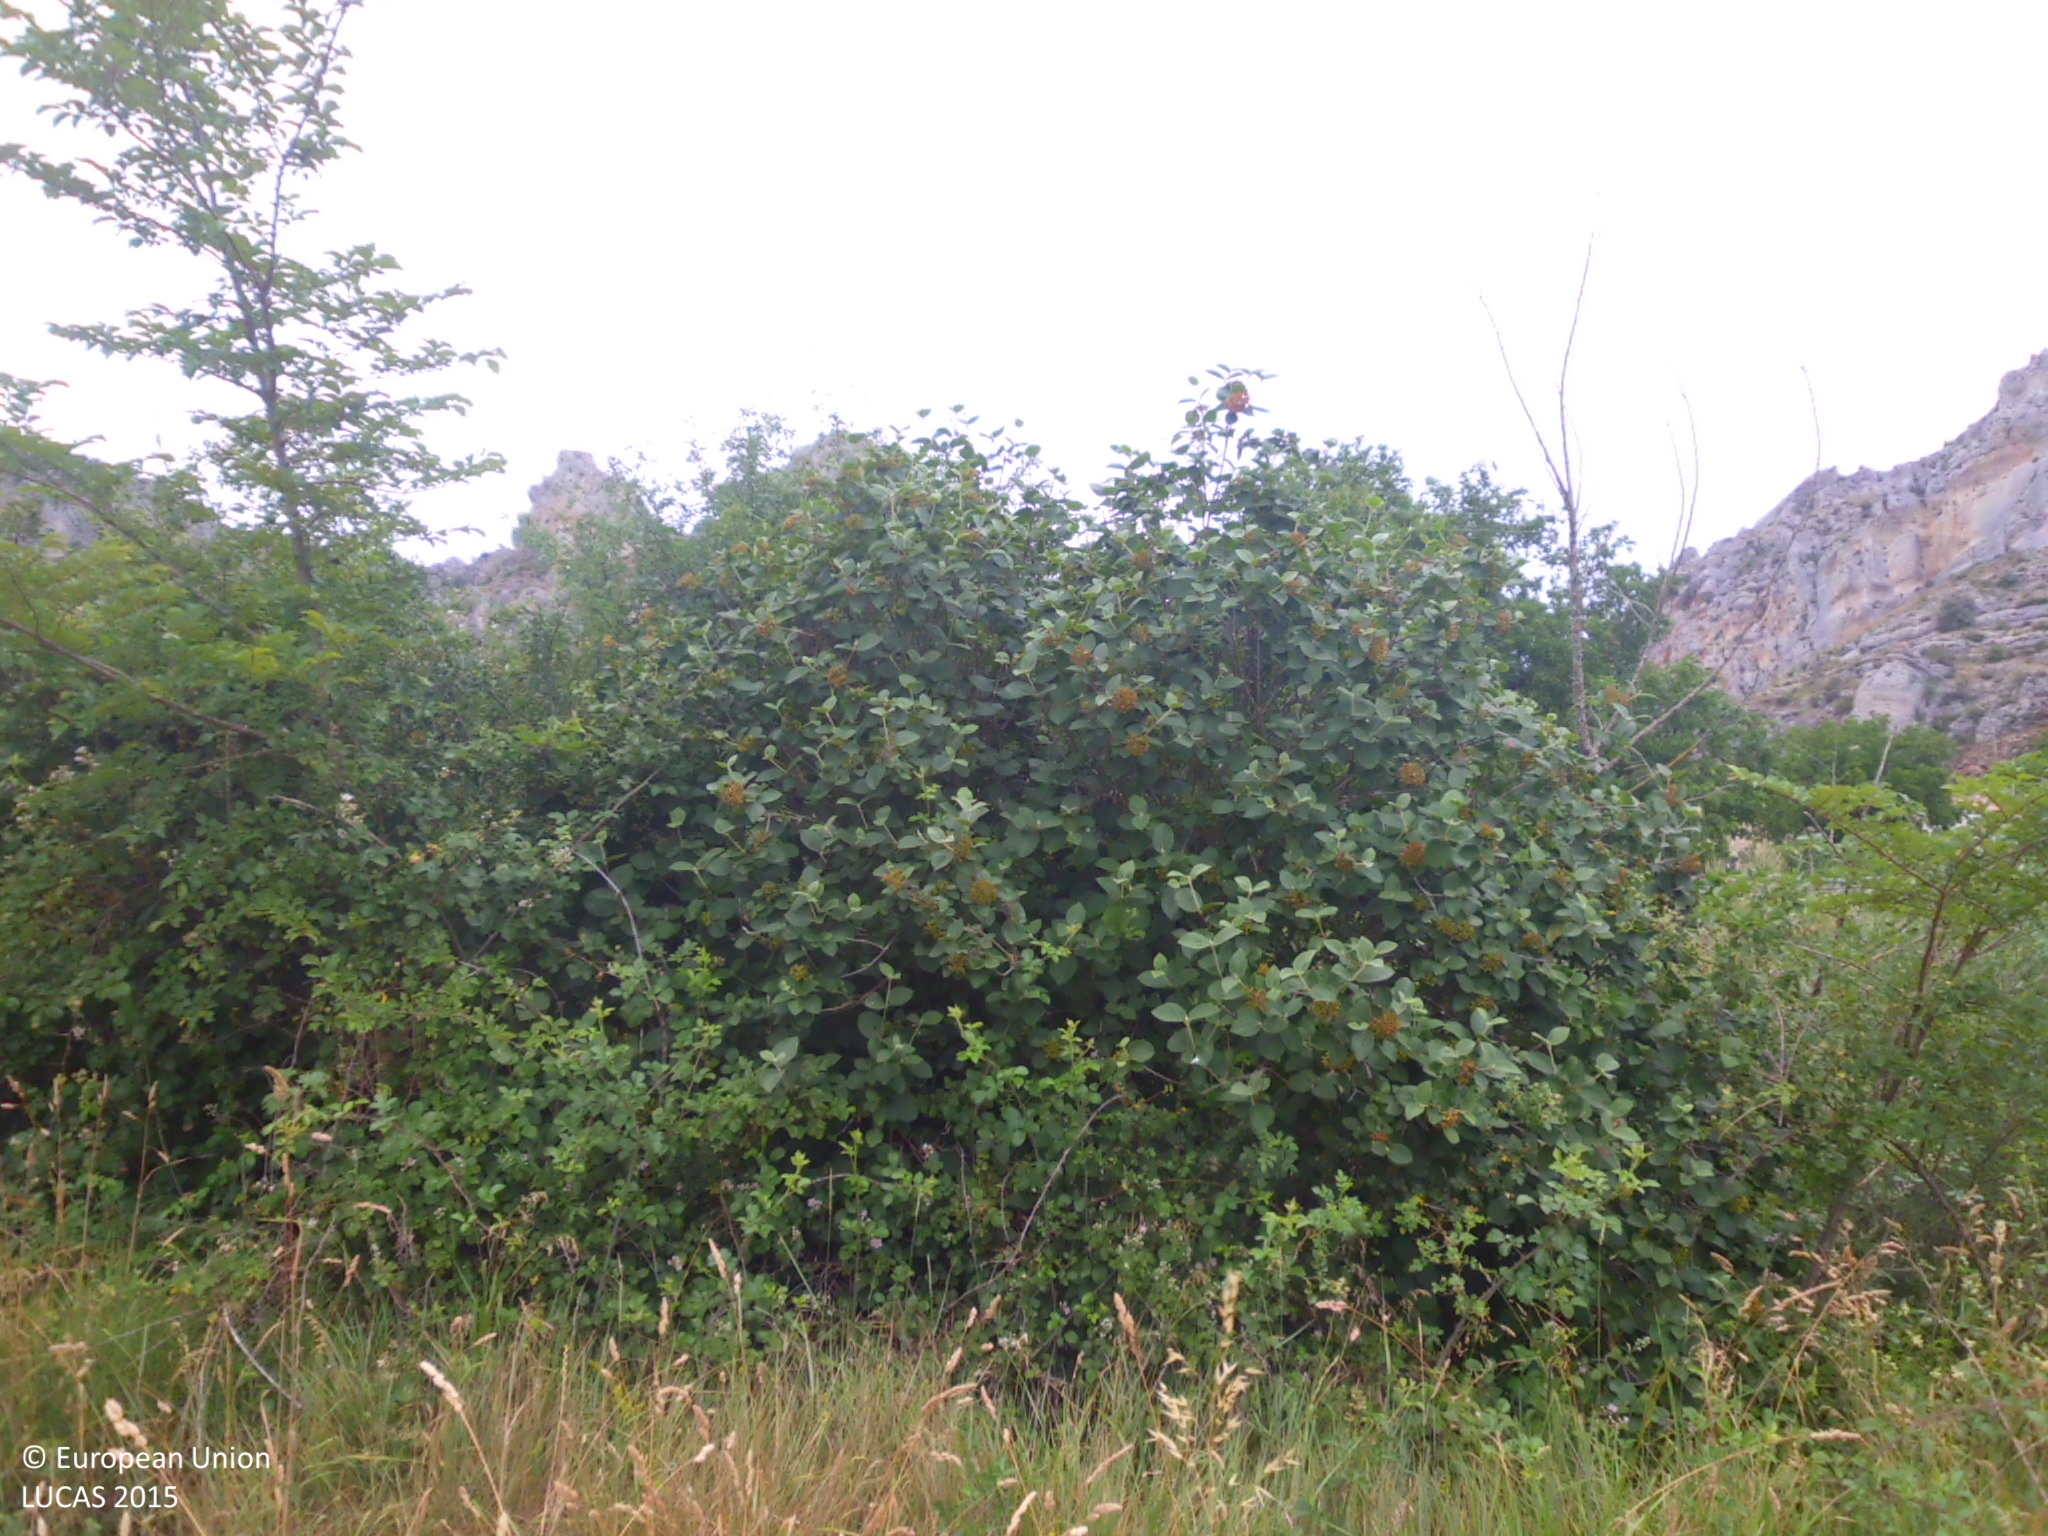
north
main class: Cropland
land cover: Common wheat
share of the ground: > 75 %
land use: Agriculture (excluding fallow land and kitchen gardens)
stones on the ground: < 10 %
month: July
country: ES
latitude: 42.7079
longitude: -3.9501
